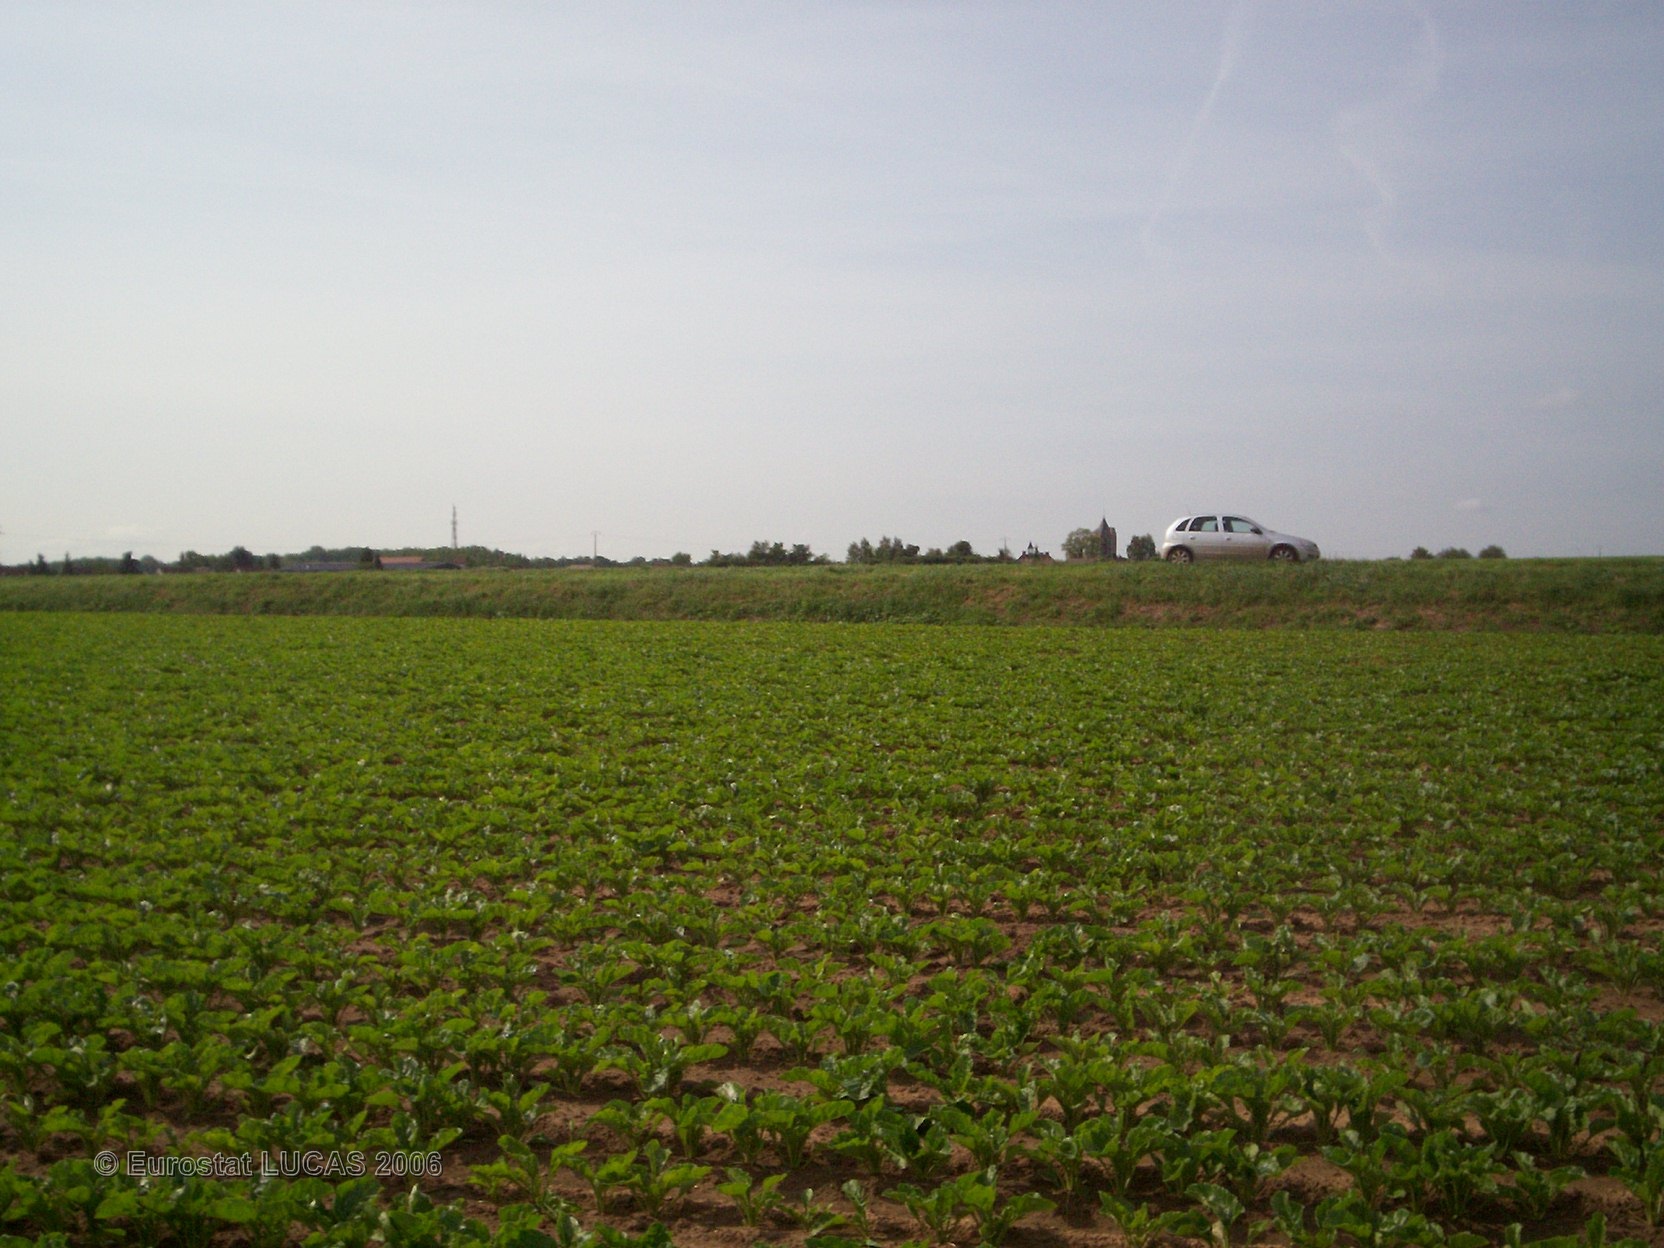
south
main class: Cropland
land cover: Sugar beet
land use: Agriculture (excluding fallow land and kitchen gardens)
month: June
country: FR
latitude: 49.2813
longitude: 2.6898
